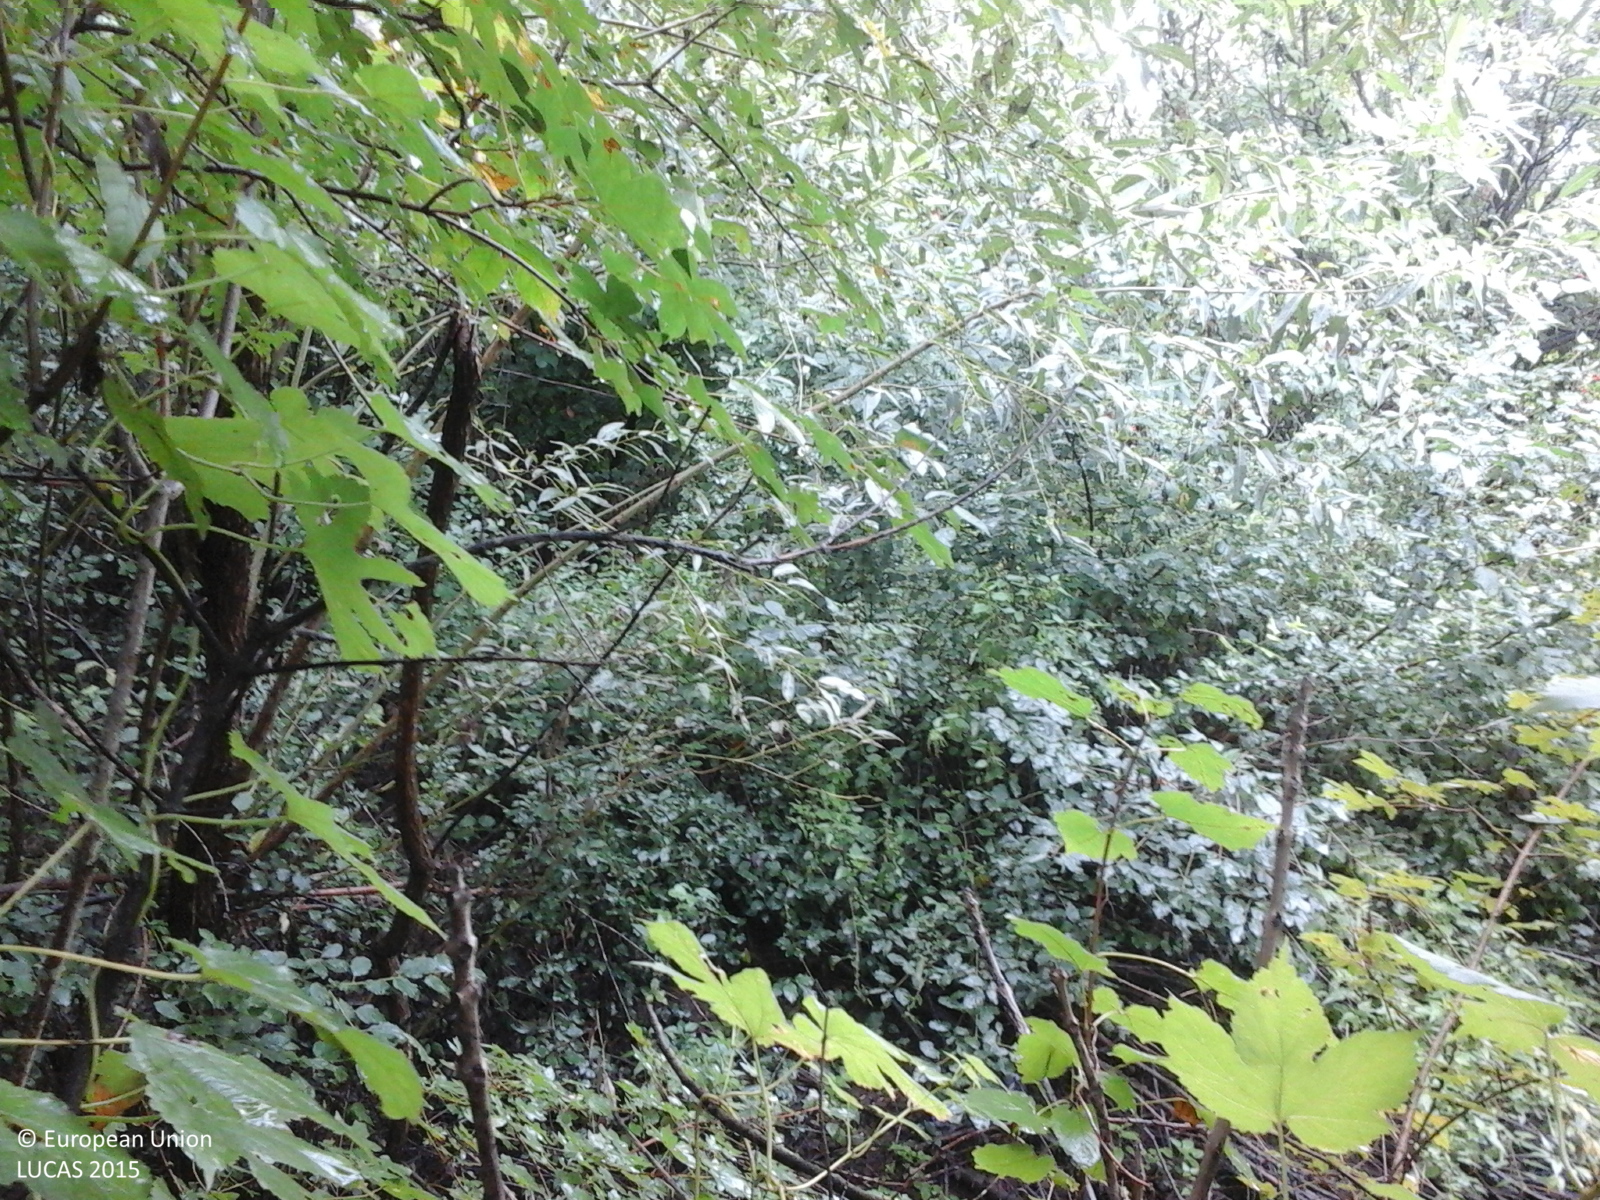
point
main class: Woodland
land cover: Broadleaved woodland
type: non-riverine alder, birch or aspen forest
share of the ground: > 75 %
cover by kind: broadleaved forest trees 100 %
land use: Forestry
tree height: > 5 m
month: September
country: RO
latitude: 46.9657
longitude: 21.9935
